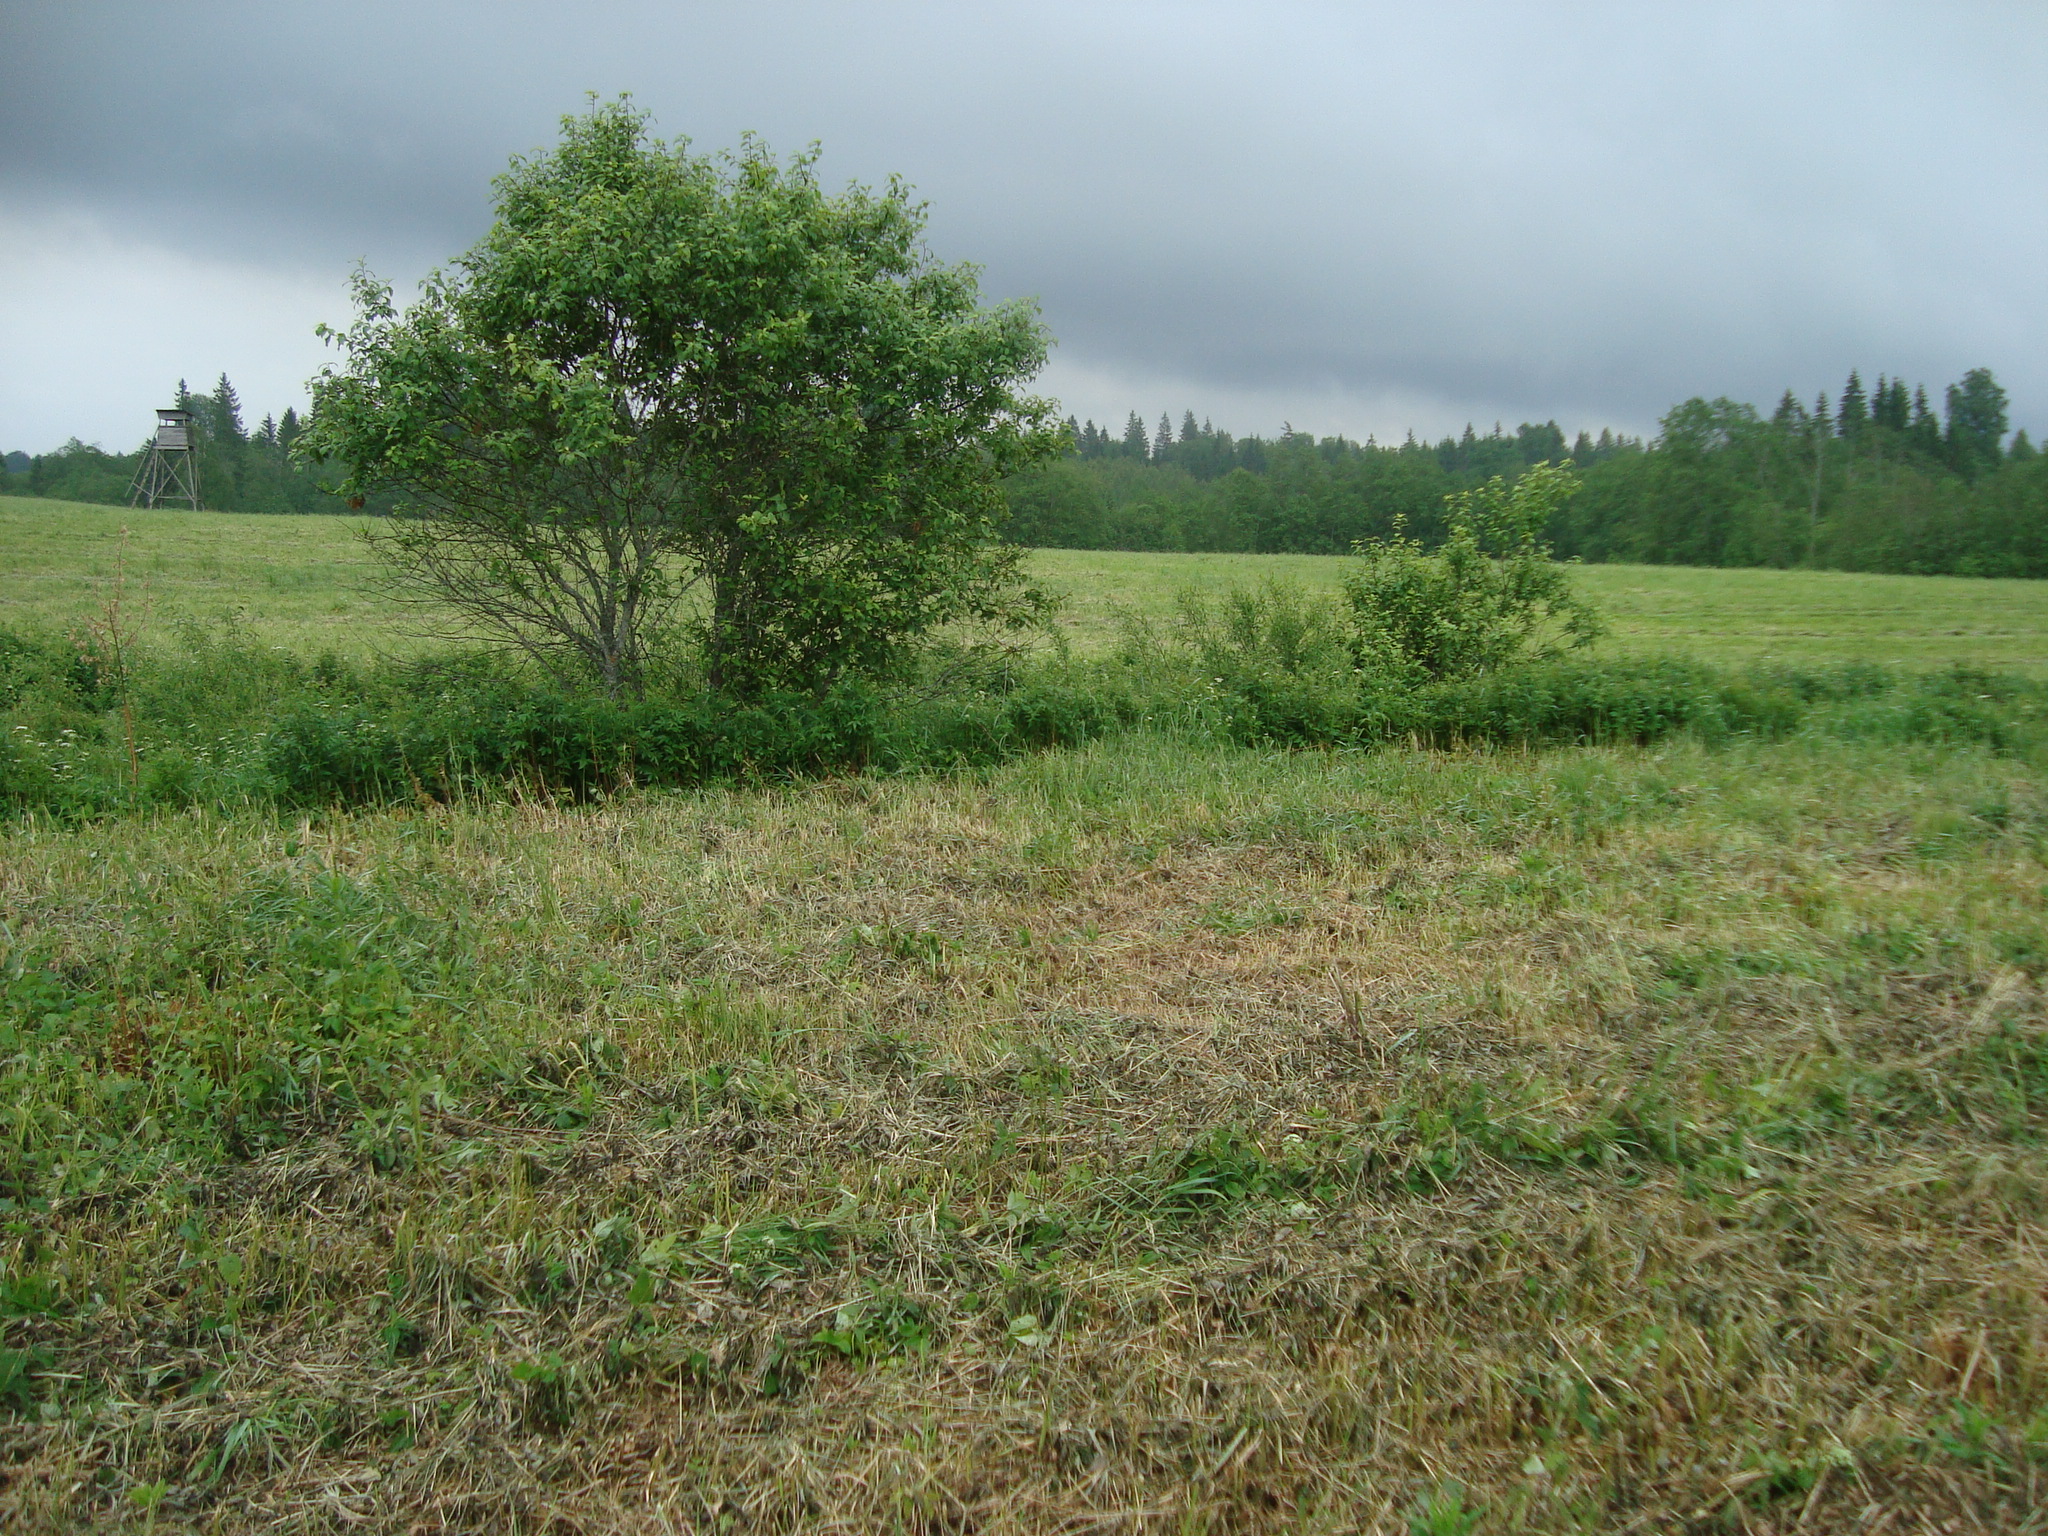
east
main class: Grassland
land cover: Grassland without tree/shrub cover
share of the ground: > 75 %
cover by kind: herbaceous plants 100 %
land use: Agriculture (excluding fallow land and kitchen gardens)
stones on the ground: < 10 %
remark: Harvested field
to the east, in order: Grassland without tree/shrub cover; Abandoned hedges; Ditches and canals; Grassland without tree/shrub cover
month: June
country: LV
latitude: 56.9830
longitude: 25.6386
